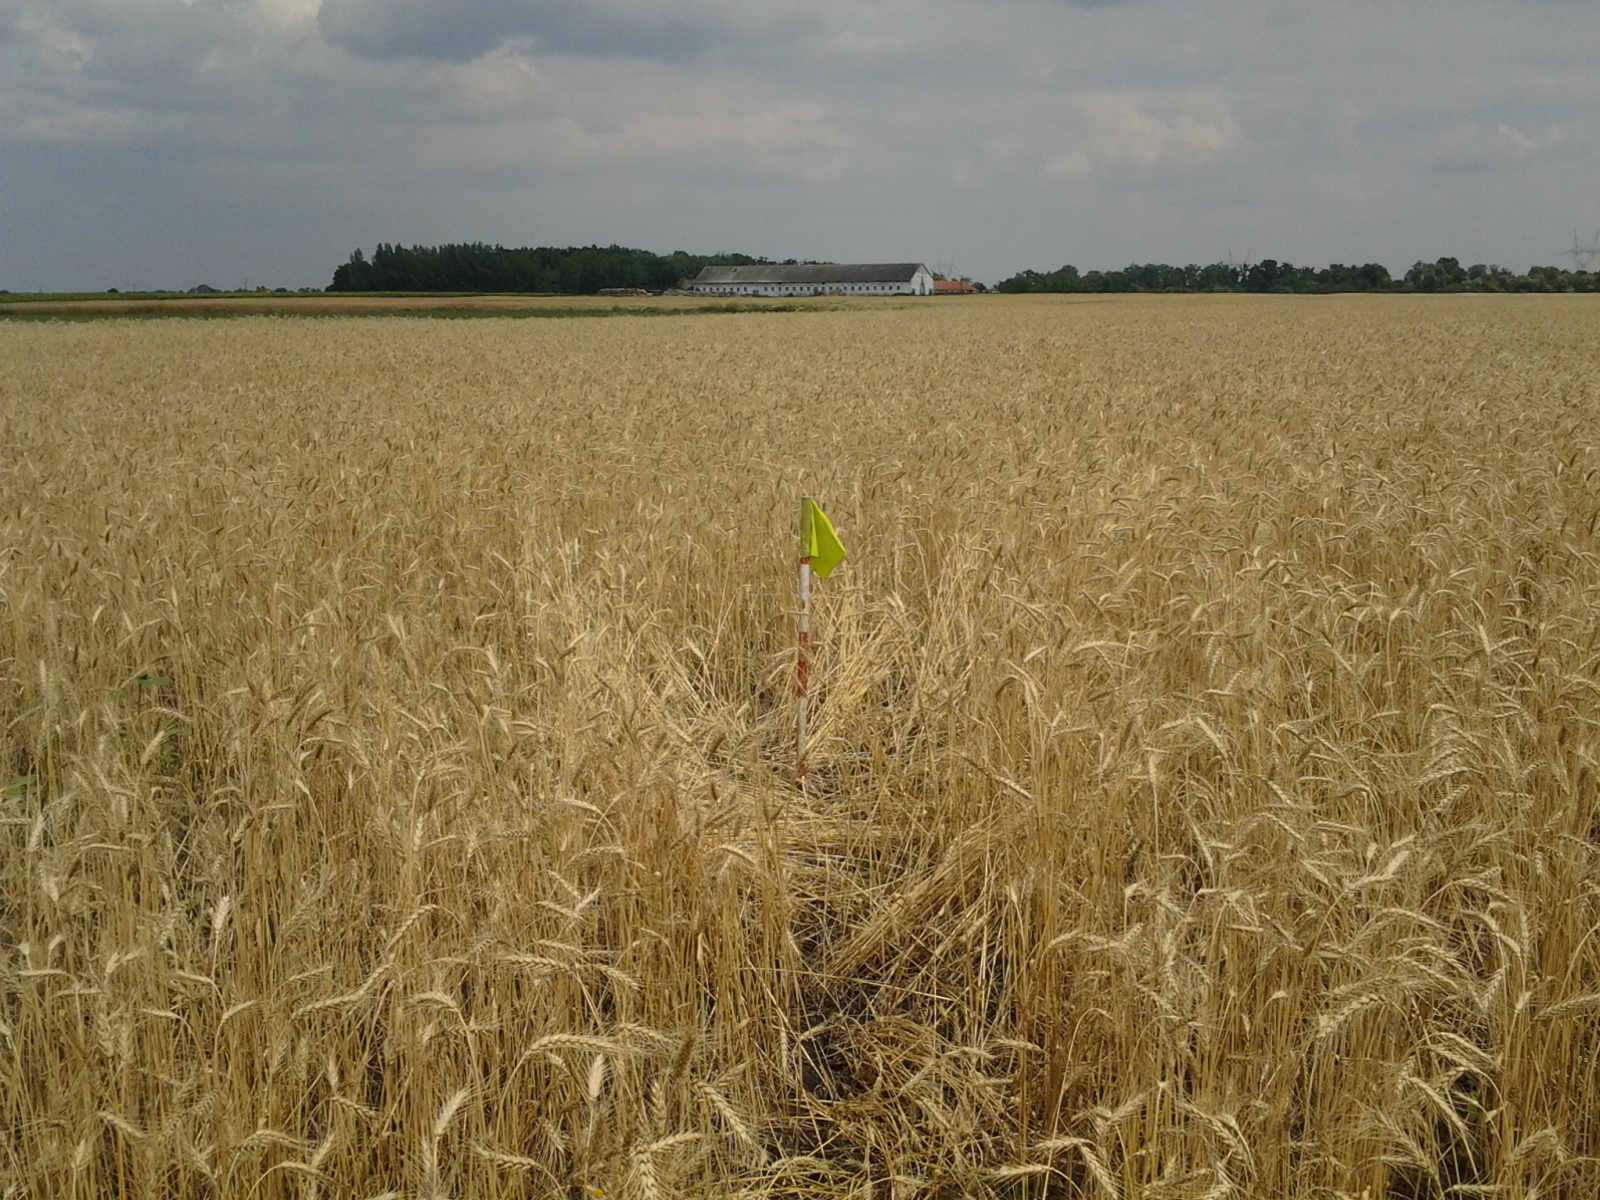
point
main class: Cropland
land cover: Triticale
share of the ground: > 75 %
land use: Agriculture (excluding fallow land and kitchen gardens)
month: June
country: HU
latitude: 47.4385
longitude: 20.2247
